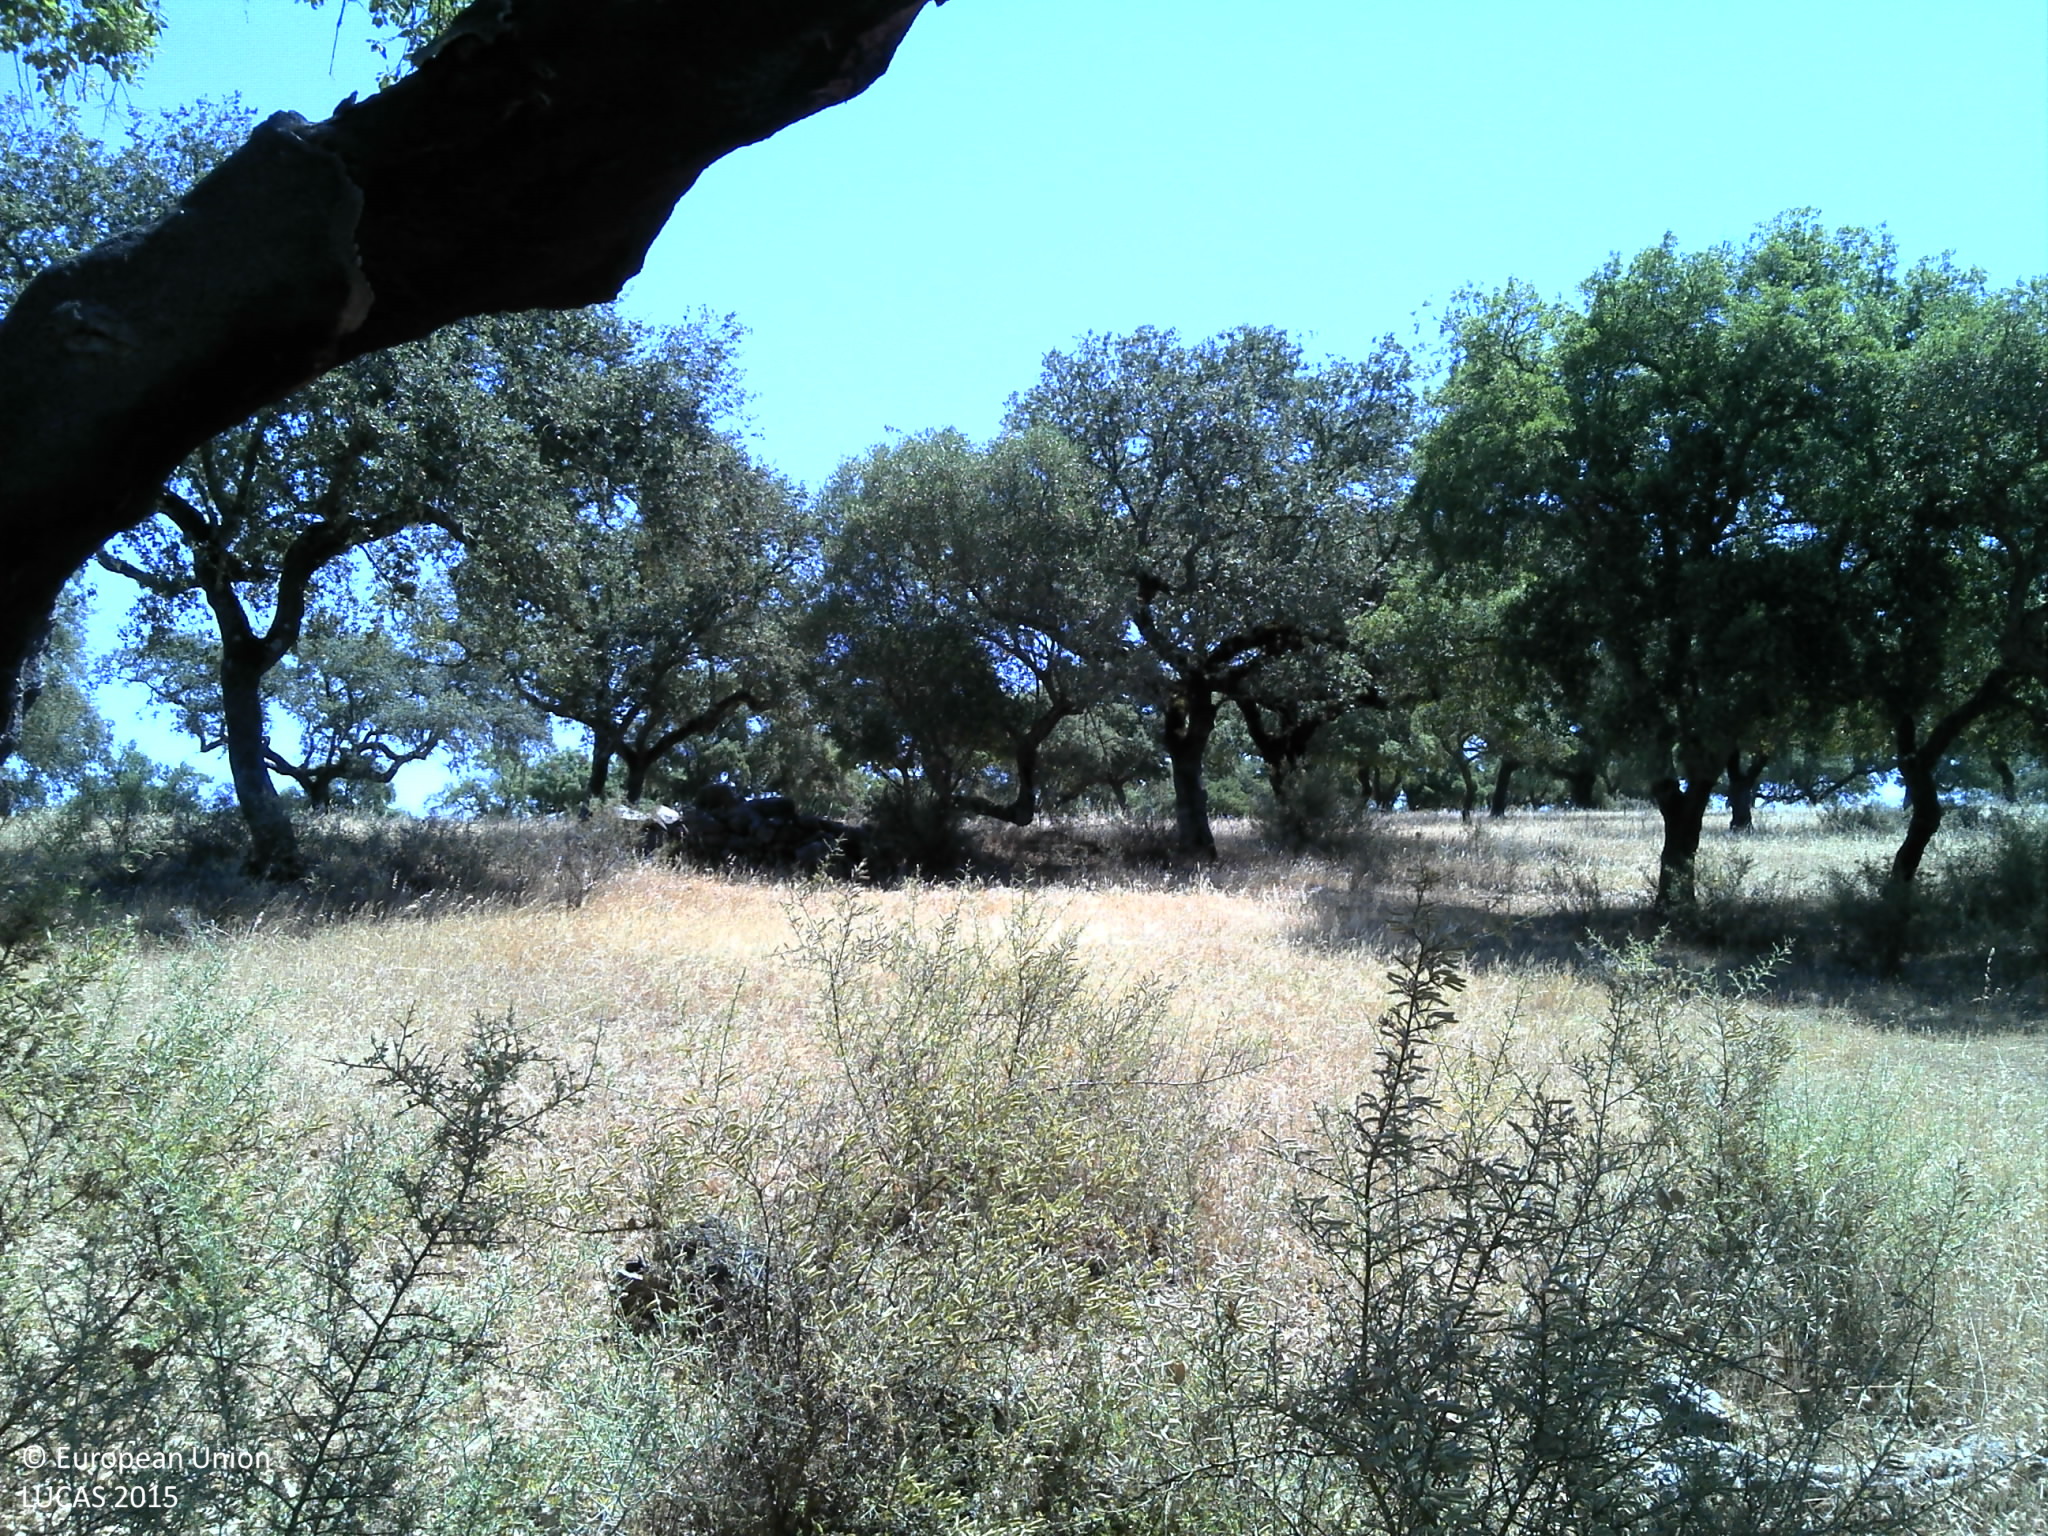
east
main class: Woodland
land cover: Broadleaved woodland
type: broadleaved evergreen forest
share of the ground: 50 - 75 %
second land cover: Grassland without tree/shrub cover
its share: 50 - 75 %
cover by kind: broadleaved forest trees 50 %, herbaceous plants 40 %, unconsolidated bare surface 10 %
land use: Forestry
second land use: Agriculture (excluding fallow land and kitchen gardens)
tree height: > 5 m
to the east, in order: Broadleaved woodland; Grassland without tree/shrub cover; Broadleaved woodland; Fences; Broadleaved woodland
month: June
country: PT
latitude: 38.7683
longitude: -7.8229
